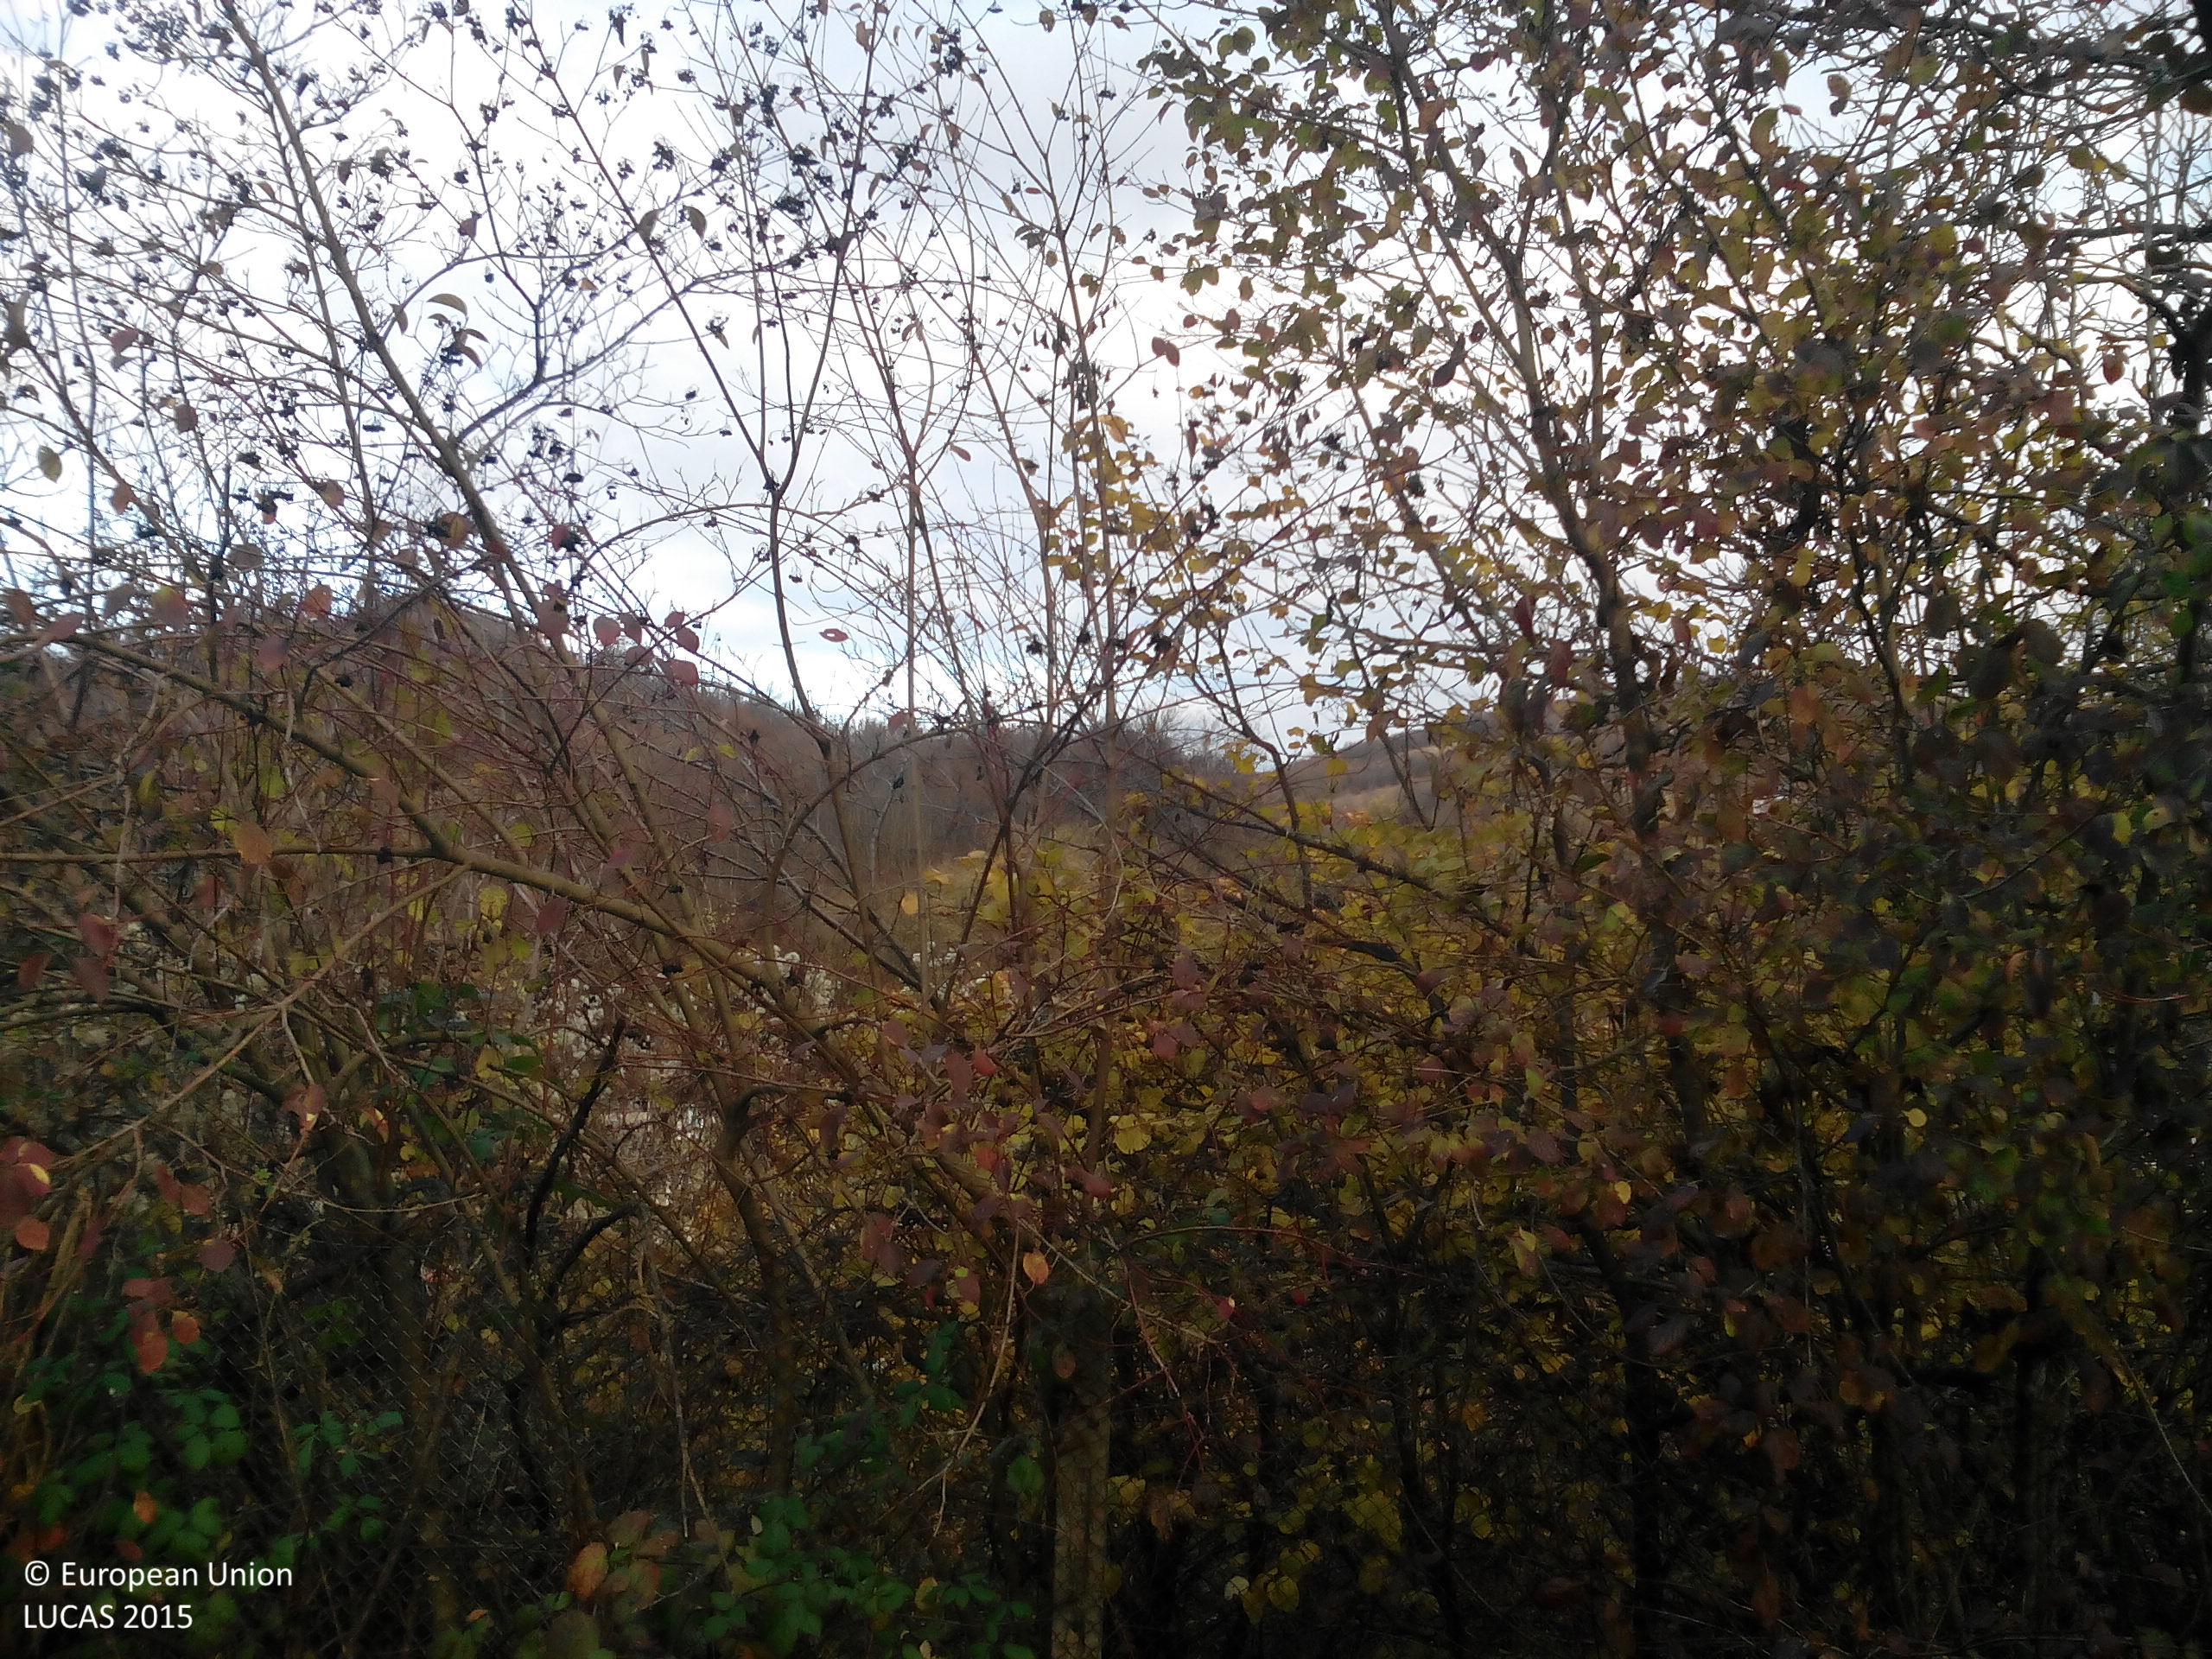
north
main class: Woodland
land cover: Broadleaved woodland
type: mesophytic deciduous forest
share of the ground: > 75 %
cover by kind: broadleaved forest trees 85 %, herbaceous plants 10 %, shrubs 5 %
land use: Residential
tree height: > 5 m
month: November
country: BG
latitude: 43.0277
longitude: 23.7522
